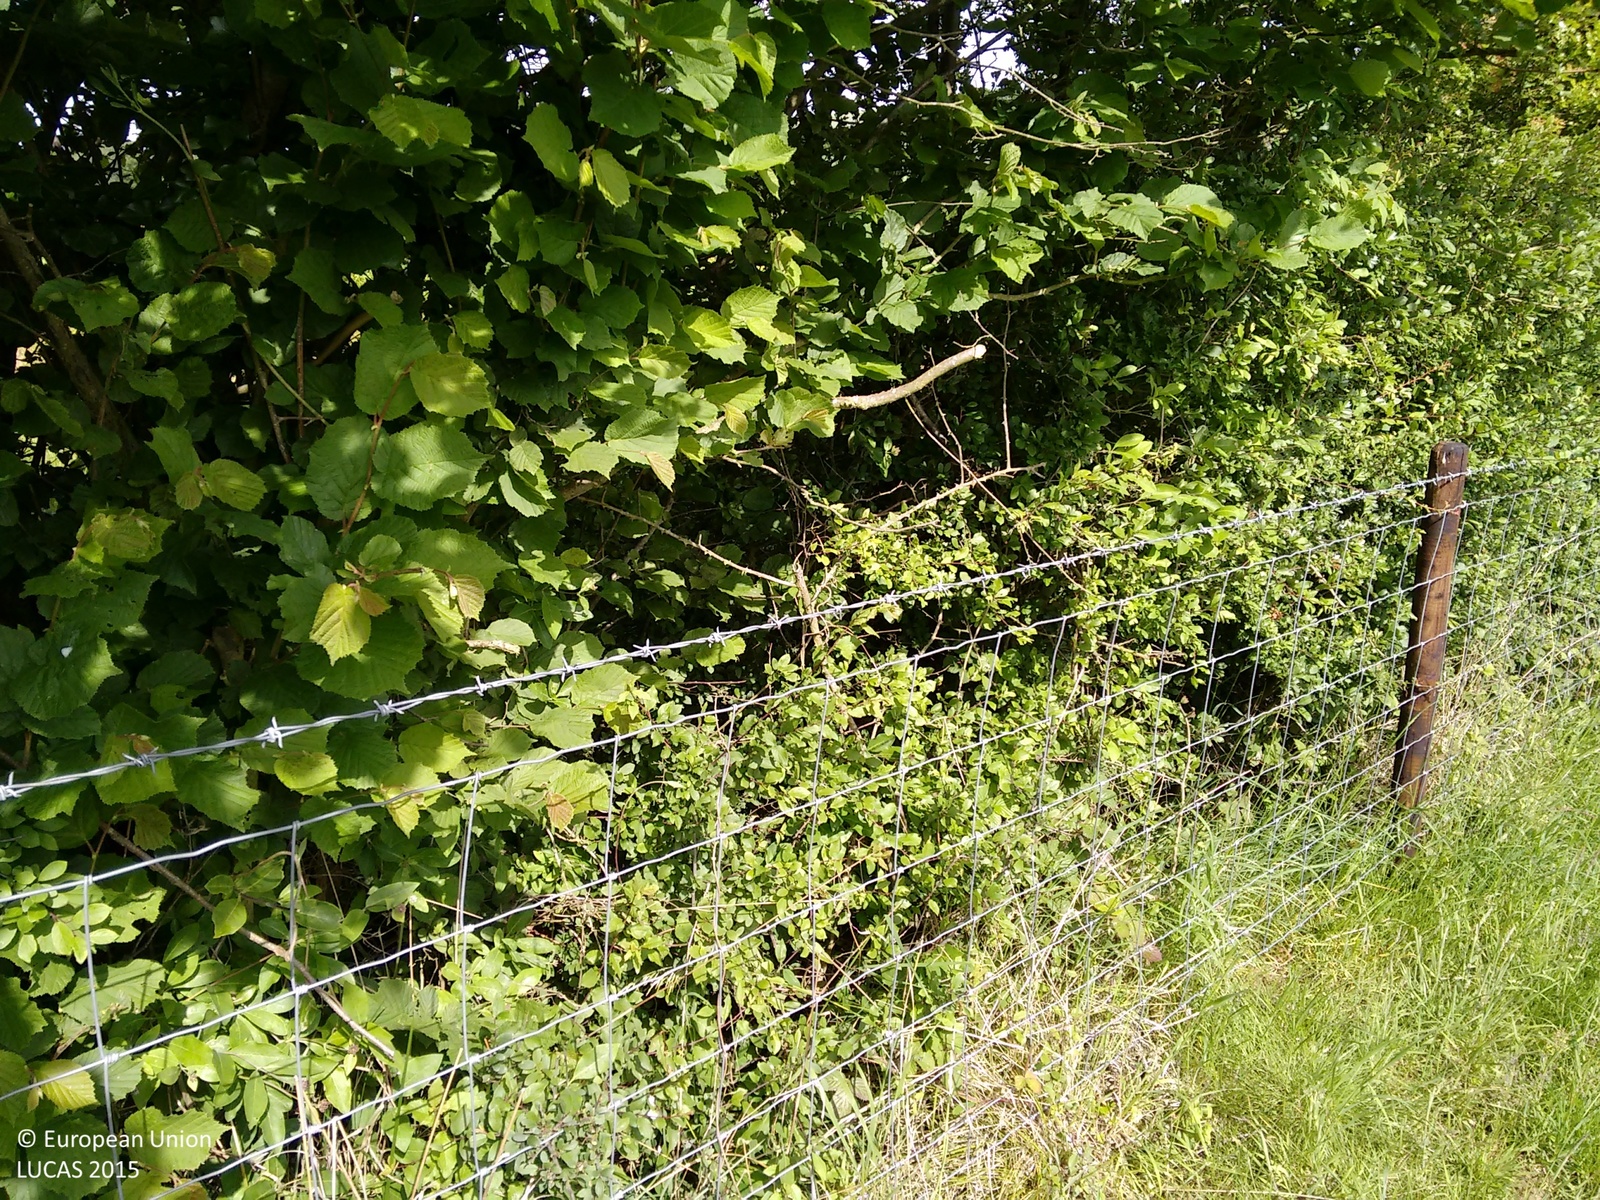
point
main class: Grassland
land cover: Grassland without tree/shrub cover
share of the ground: > 75 %
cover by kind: herbaceous plants 100 %
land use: Agriculture (excluding fallow land and kitchen gardens)
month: June
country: GB
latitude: 53.3452
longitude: -0.0512
